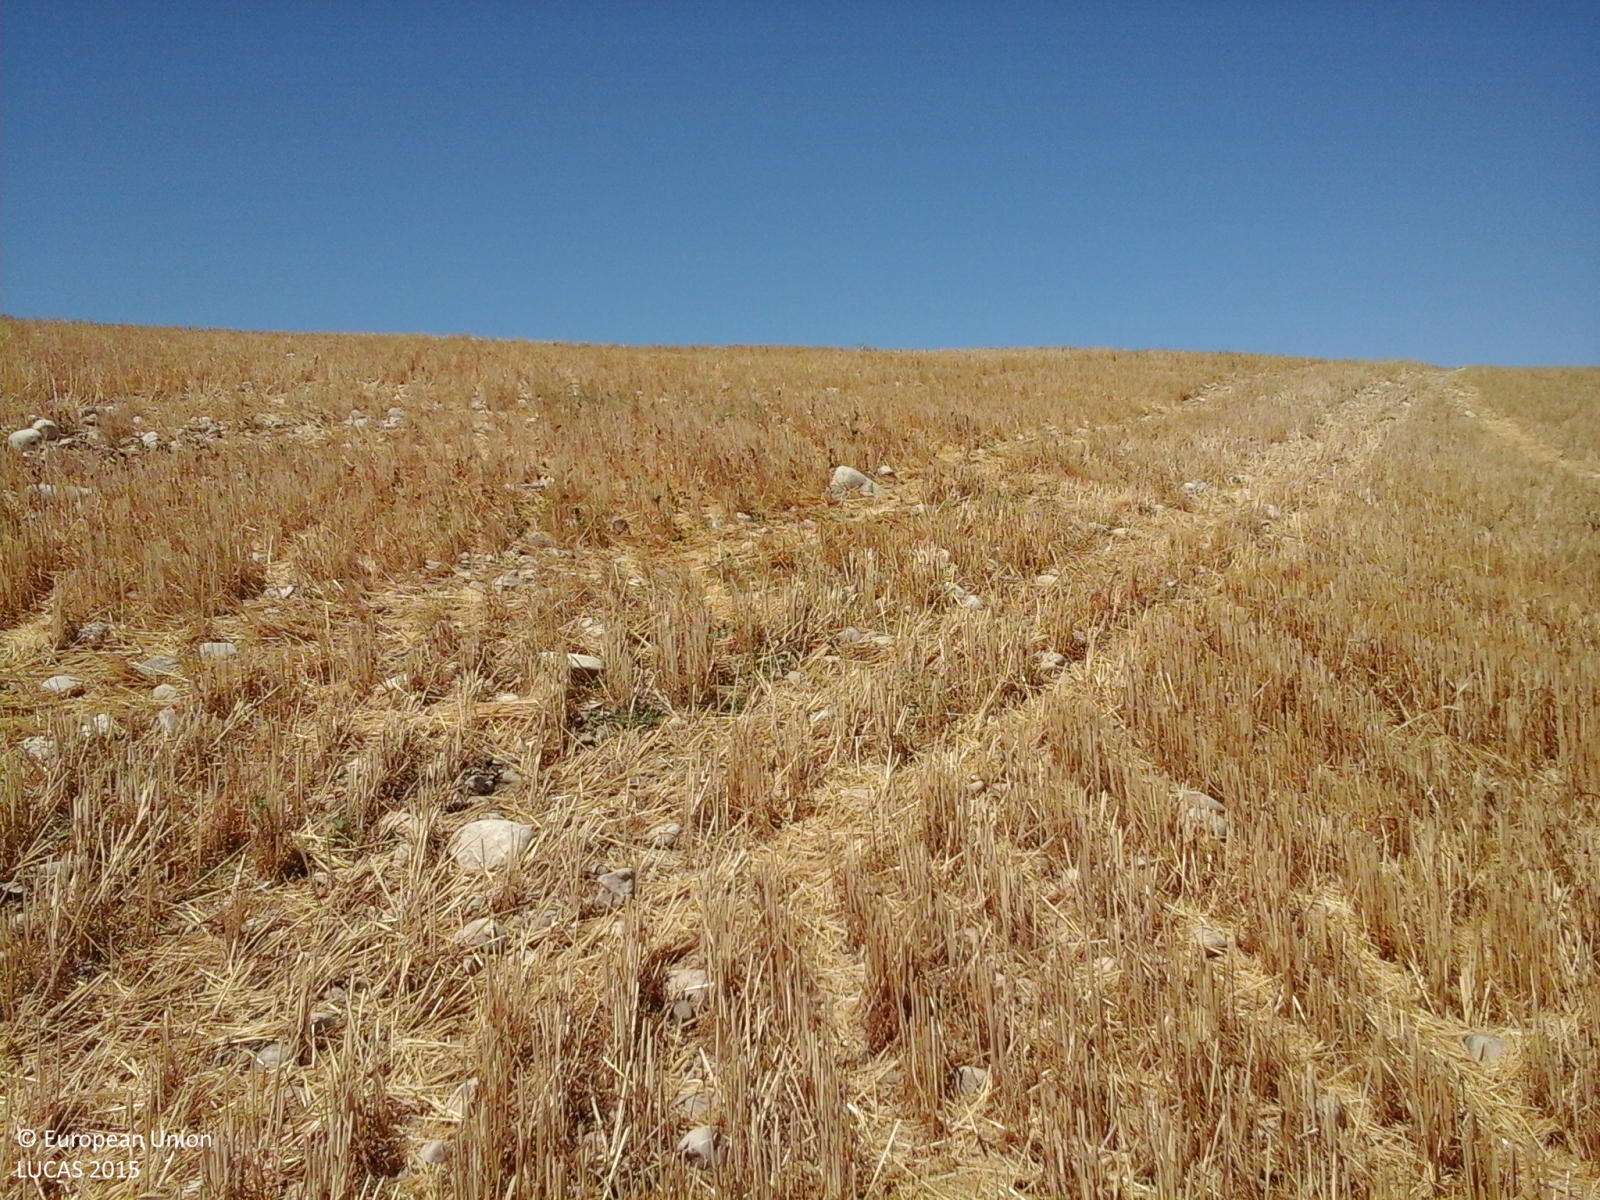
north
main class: Cropland
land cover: Durum wheat
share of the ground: > 75 %
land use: Agriculture (excluding fallow land and kitchen gardens)
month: June
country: IT
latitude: 41.7090
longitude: 15.1393
